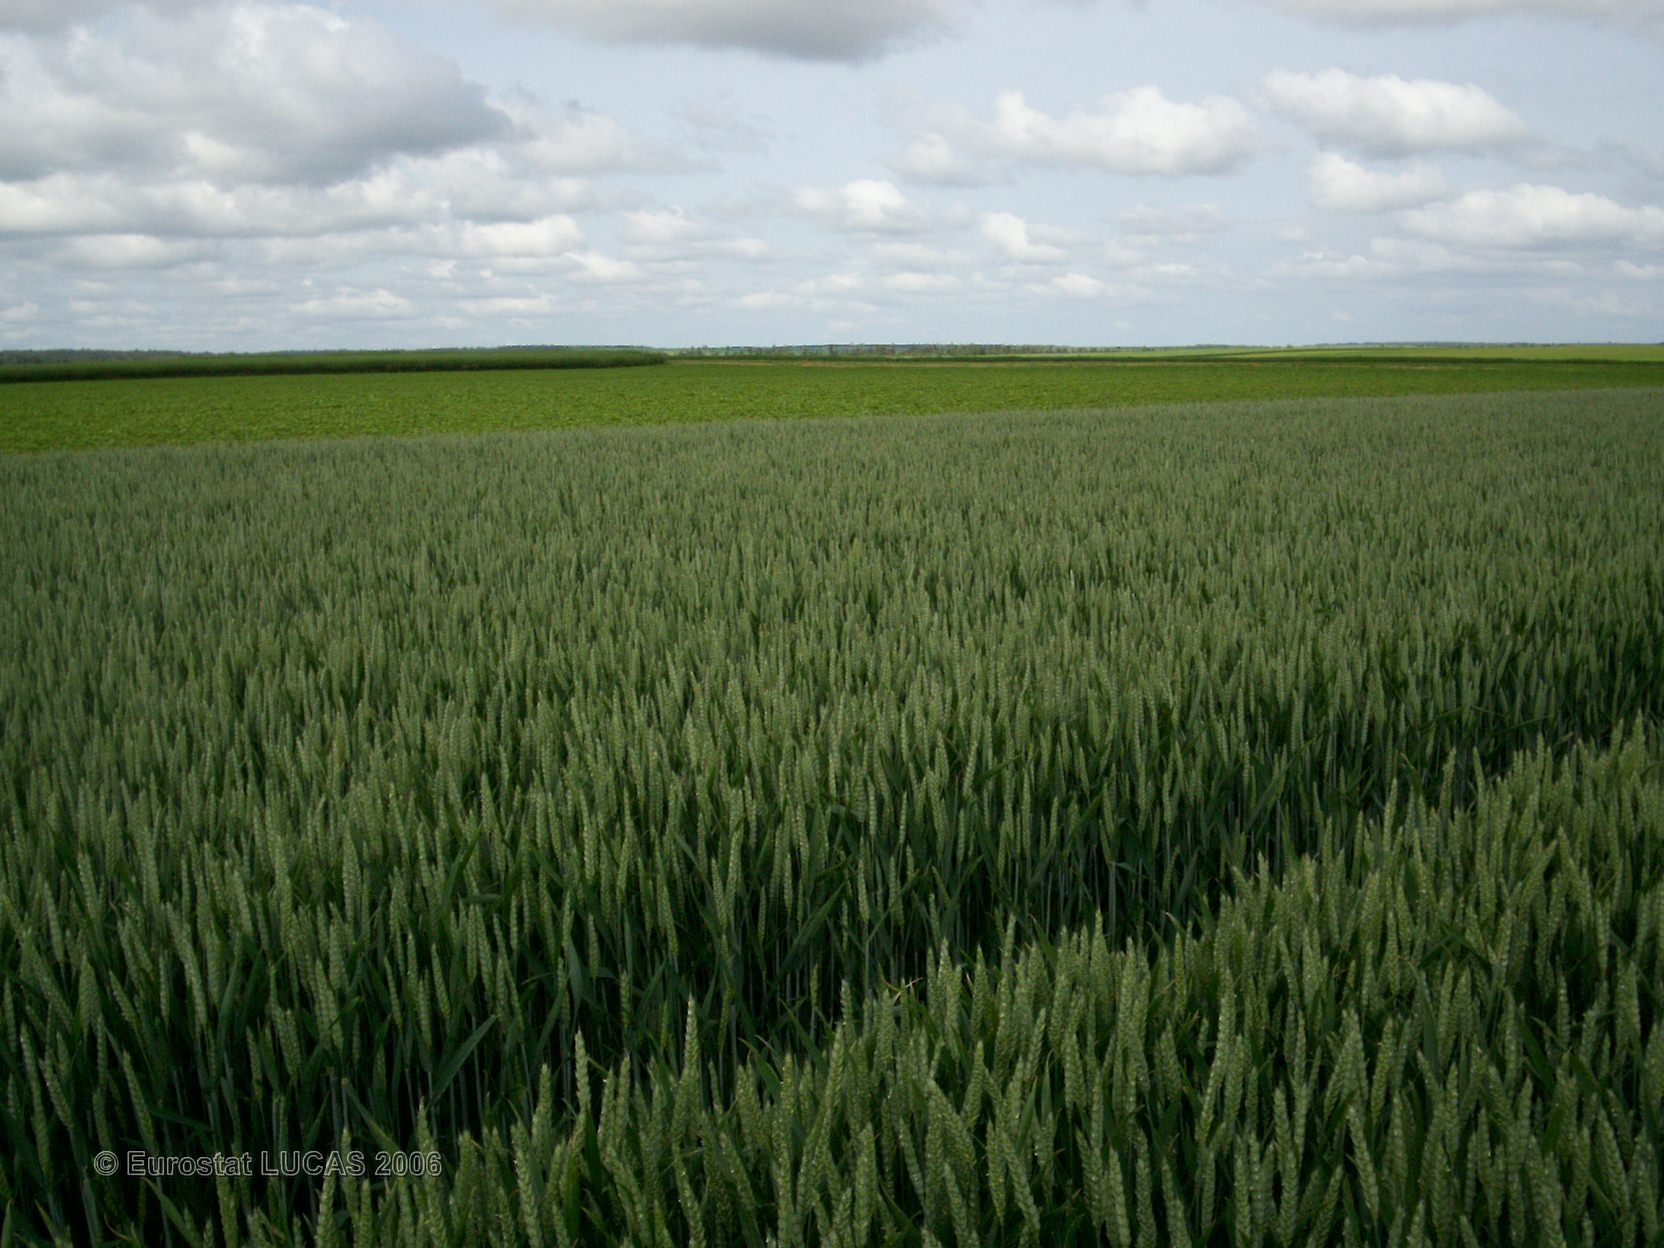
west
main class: Cropland
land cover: Common wheat
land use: Agriculture (excluding fallow land and kitchen gardens)
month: June
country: FR
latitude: 48.3469
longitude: 3.9645
